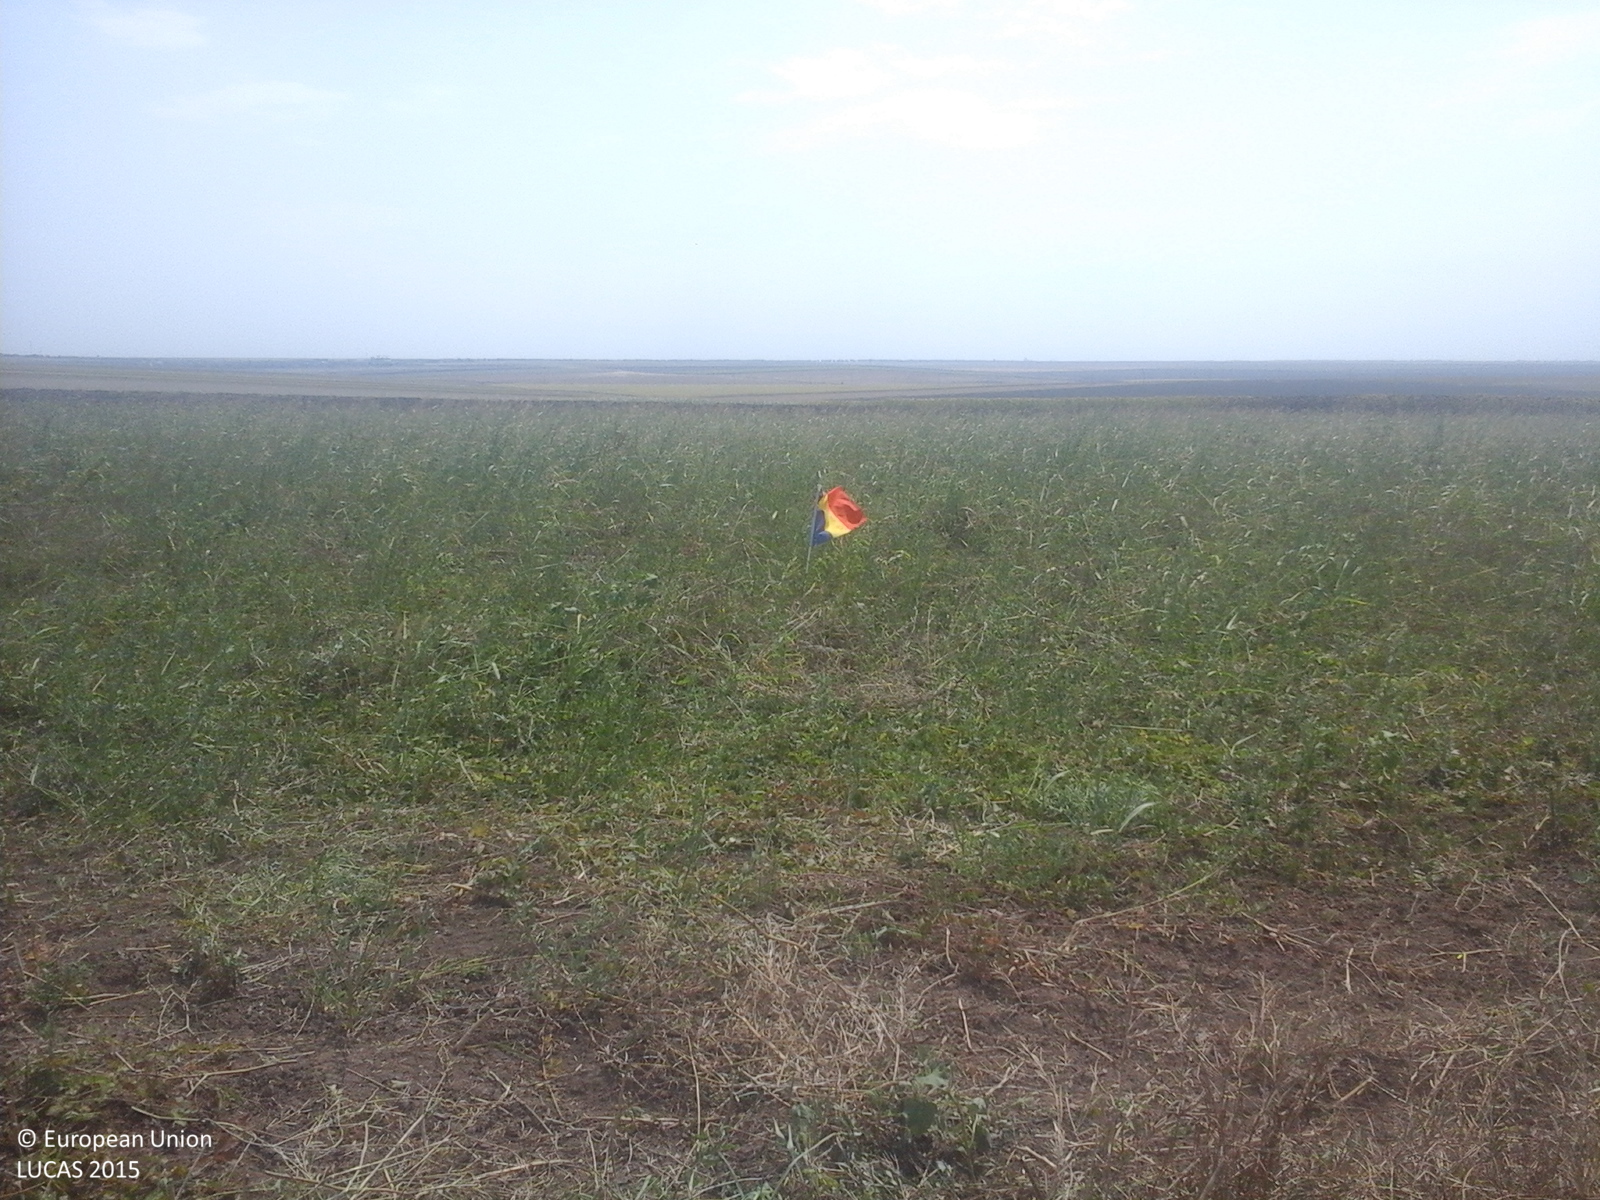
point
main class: Grassland
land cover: Spontaneously vegetated surfaces
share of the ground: < 10 %
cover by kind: herbaceous plants 100 %
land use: Fallow land
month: August
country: RO
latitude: 43.9404
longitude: 28.3127
